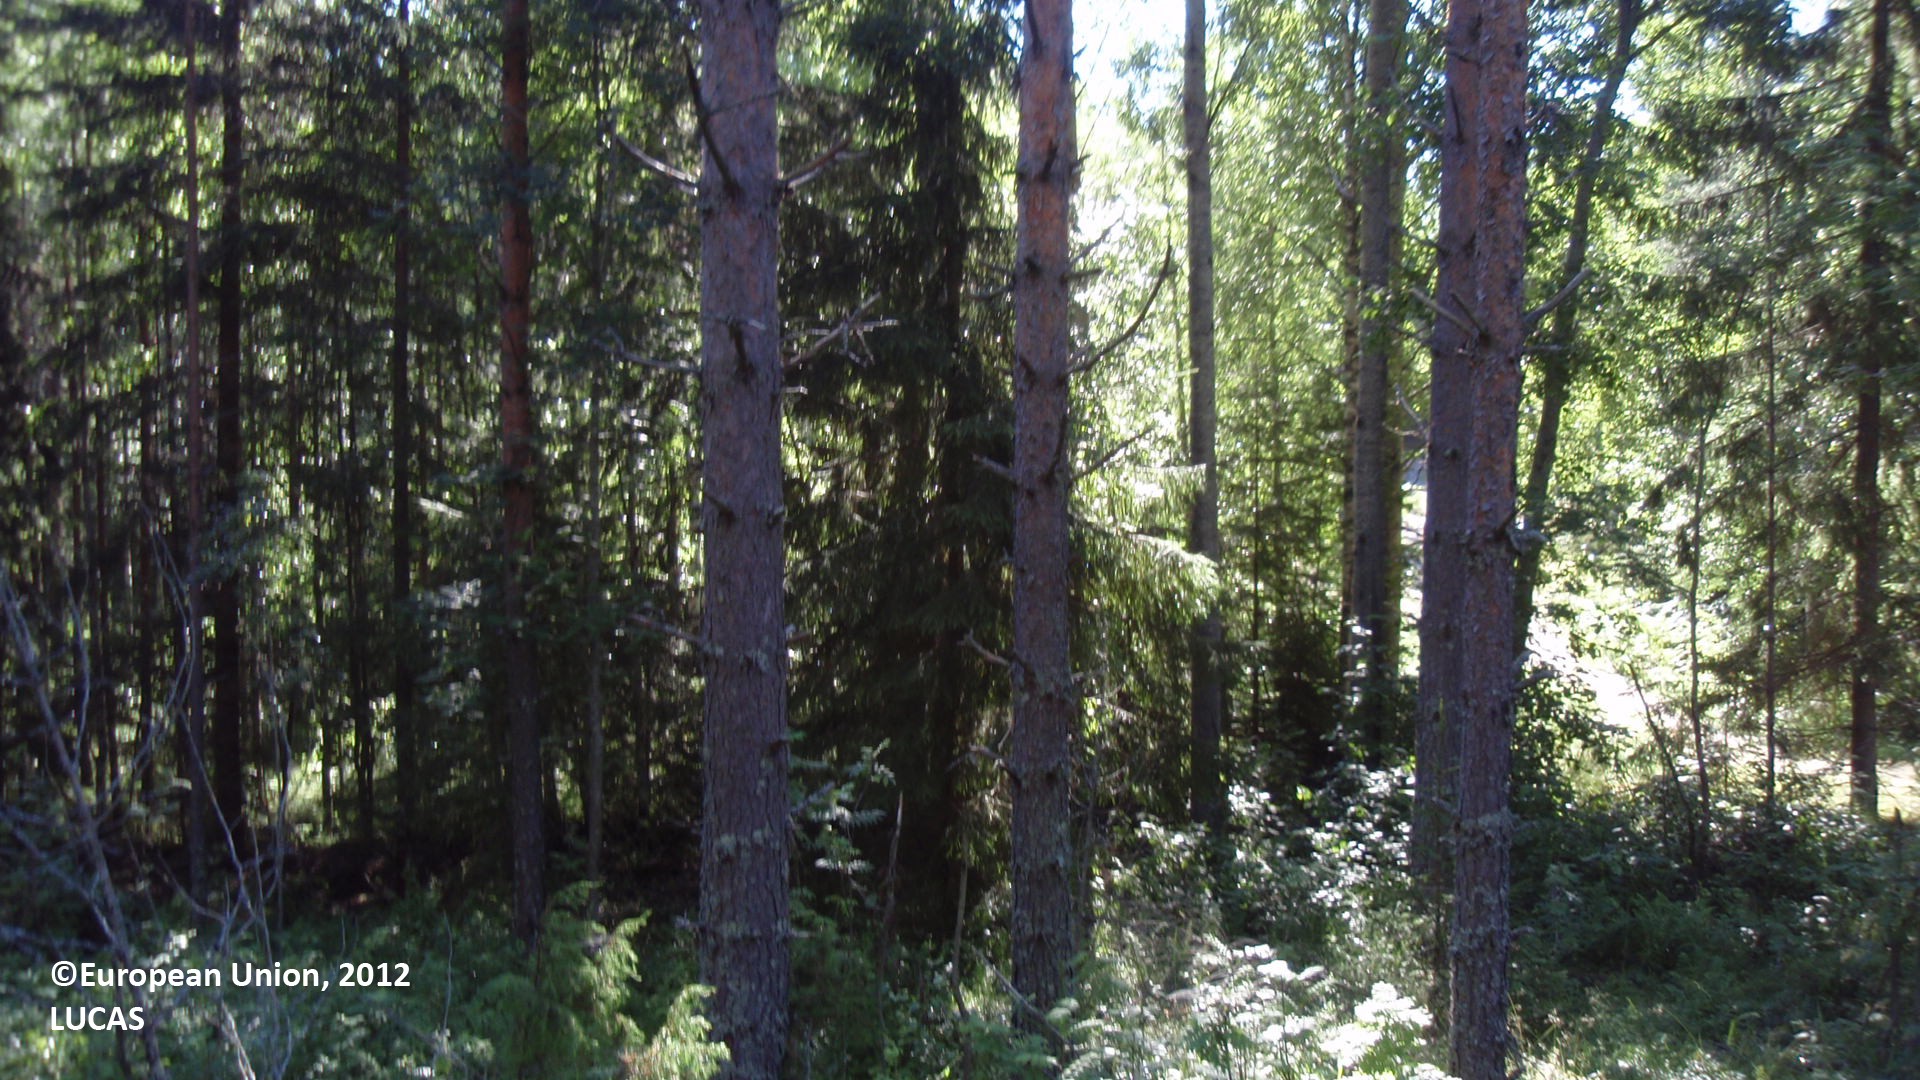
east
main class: Woodland
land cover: Pine dominated coniferous woodland
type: boreal forest
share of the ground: 50 - 75 %
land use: Forestry
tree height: > 5 m
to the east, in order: Pine dominated coniferous woodland; Spruce dominated mixed woodland; Pine dominated coniferous woodland; Shrubland with sparse tree cover; Paved roads, cycling and walking lanes; Ditches and canals; Pine dominated coniferous woodland; Inland marshes; Pine dominated coniferous woodland; Lichens and moss; Spruce dominated mixed woodland; Ditches and canals; Paved roads, cycling and walking lanes; Pine dominated mixed woodland
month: July
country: FI
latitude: 61.5770
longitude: 28.2247
